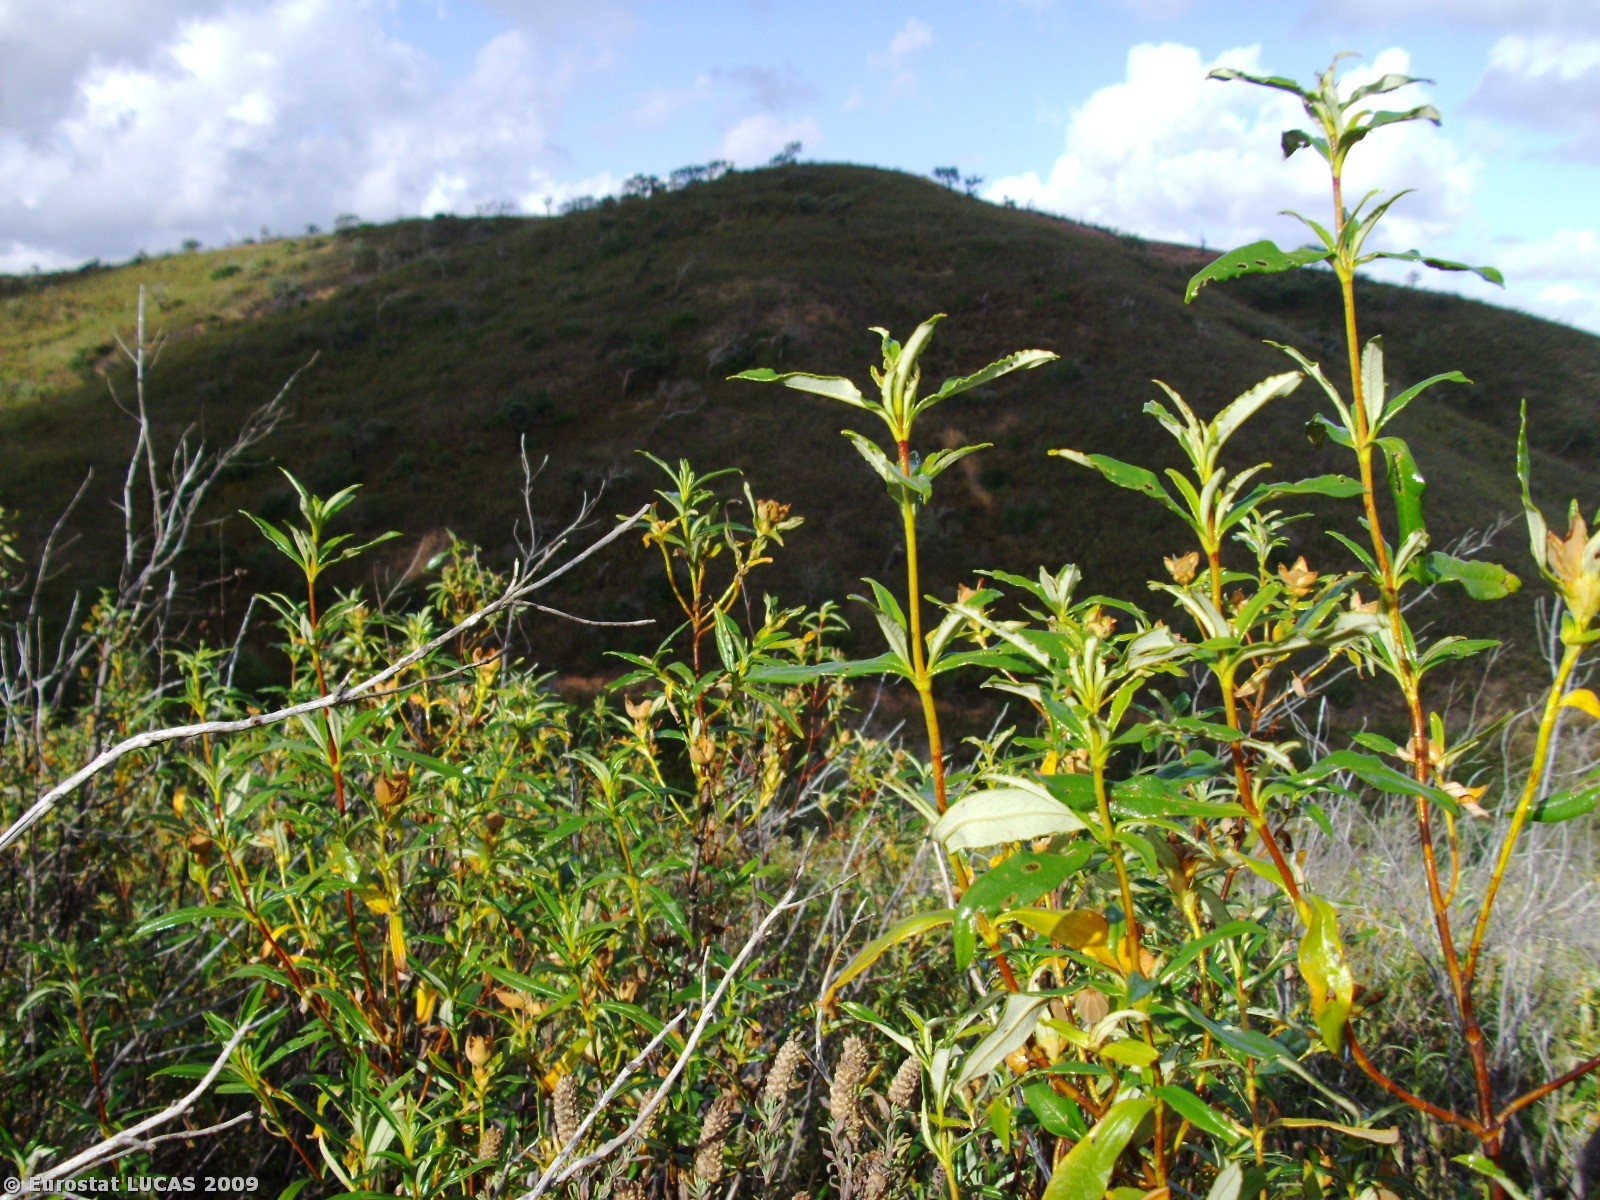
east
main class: Shrubland
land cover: Shrubland without tree cover
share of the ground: > 75 %
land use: Unused
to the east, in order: Shrubland without tree cover; Tracks; Shrubland with sparse tree cover; Tracks; Shrubland with sparse tree cover
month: June
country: PT
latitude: 37.2182
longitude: -8.7509
